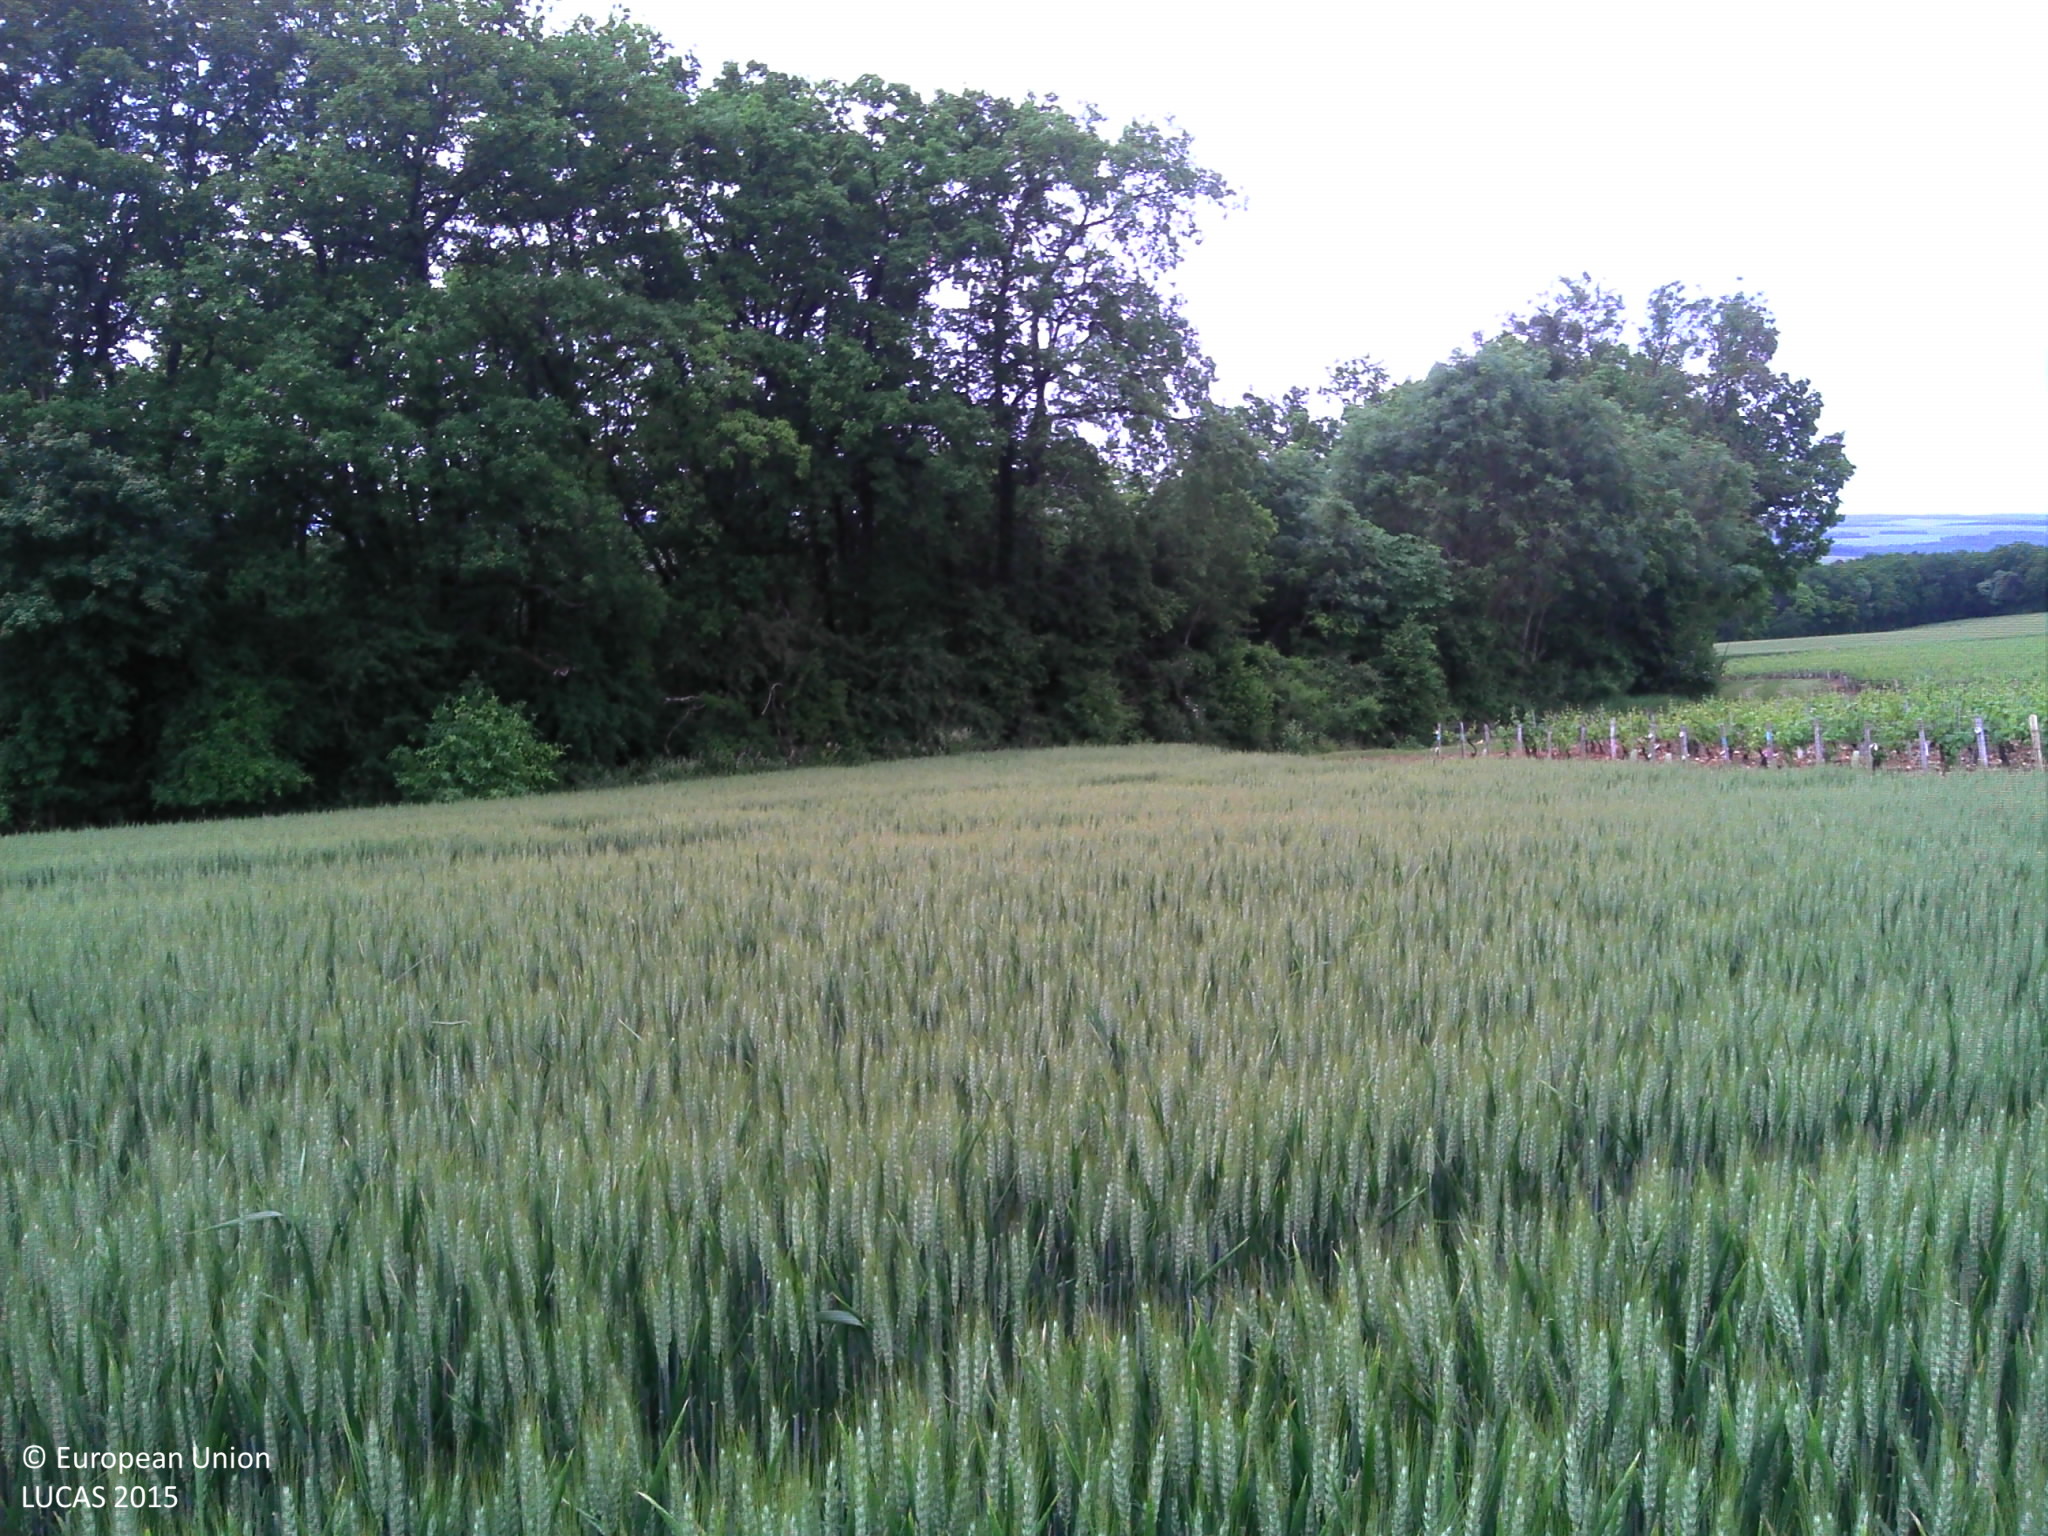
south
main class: Cropland
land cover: Common wheat
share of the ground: > 75 %
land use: Agriculture (excluding fallow land and kitchen gardens)
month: May
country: FR
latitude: 47.7852
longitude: 3.9238
